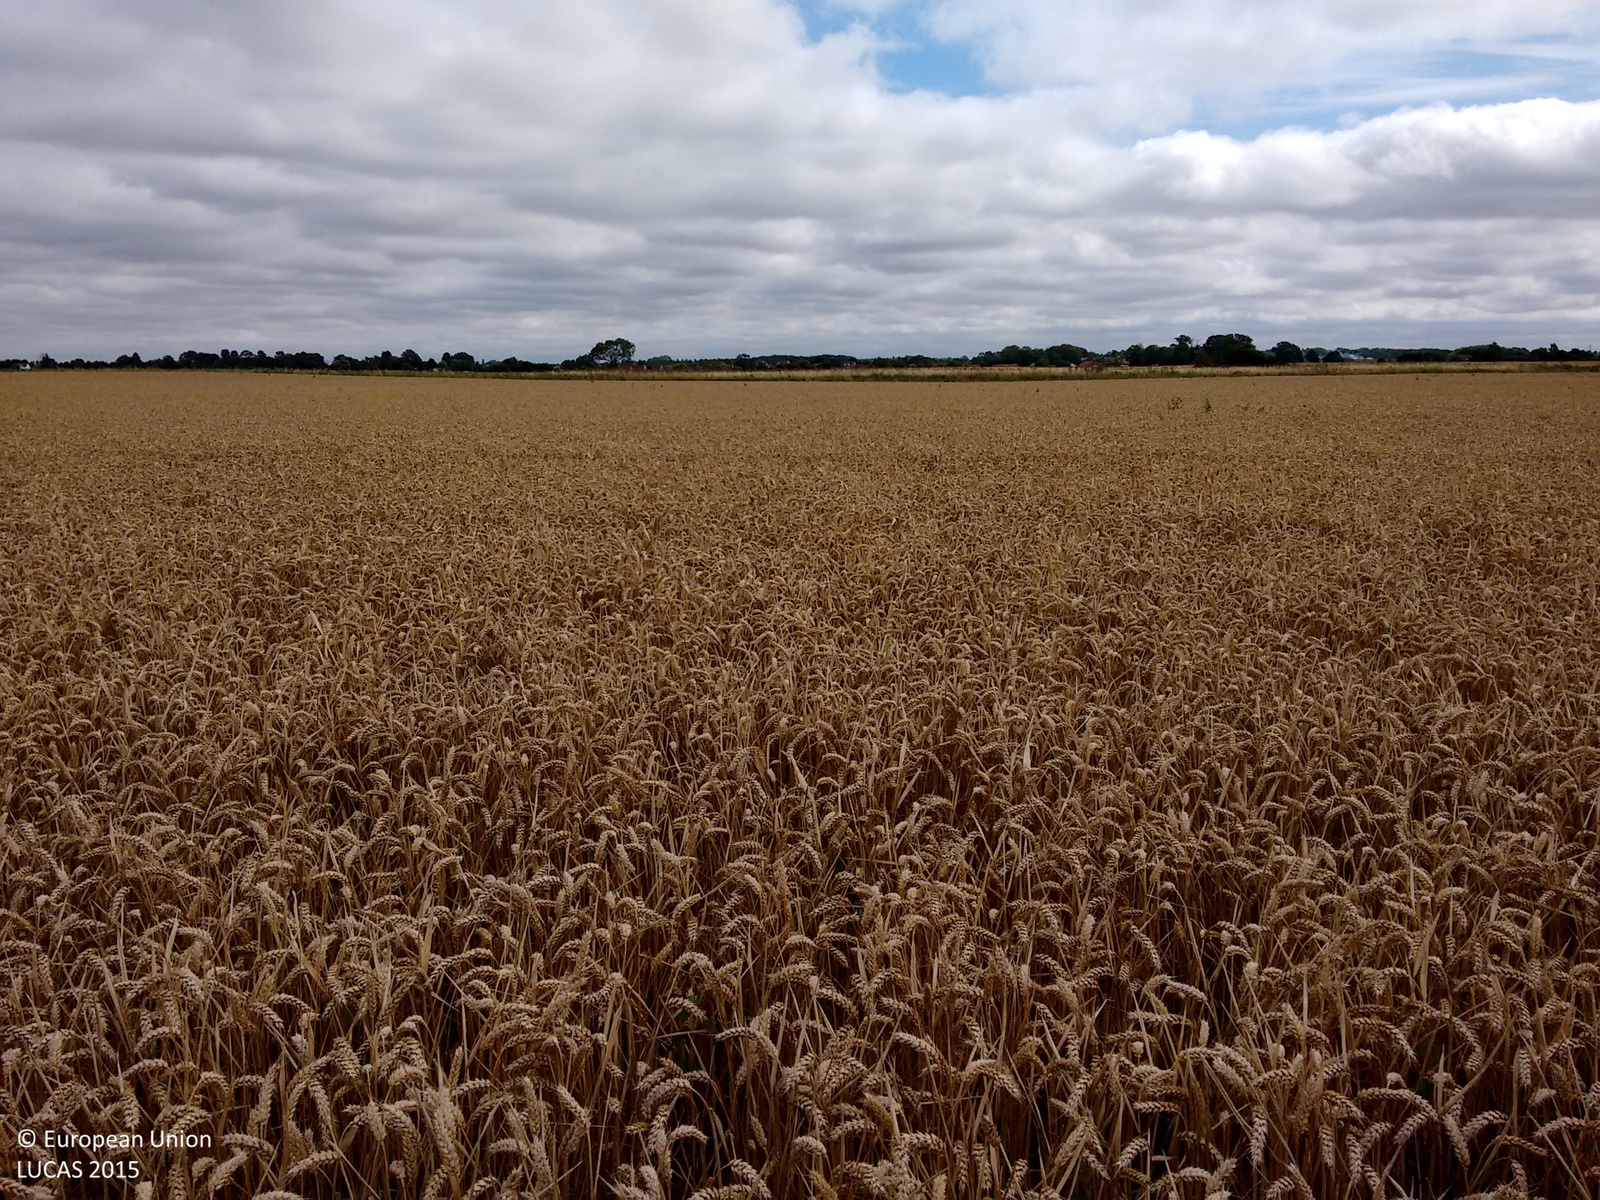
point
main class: Cropland
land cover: Common wheat
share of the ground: > 75 %
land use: Agriculture (excluding fallow land and kitchen gardens)
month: August
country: GB
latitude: 52.6356
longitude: 0.3517
